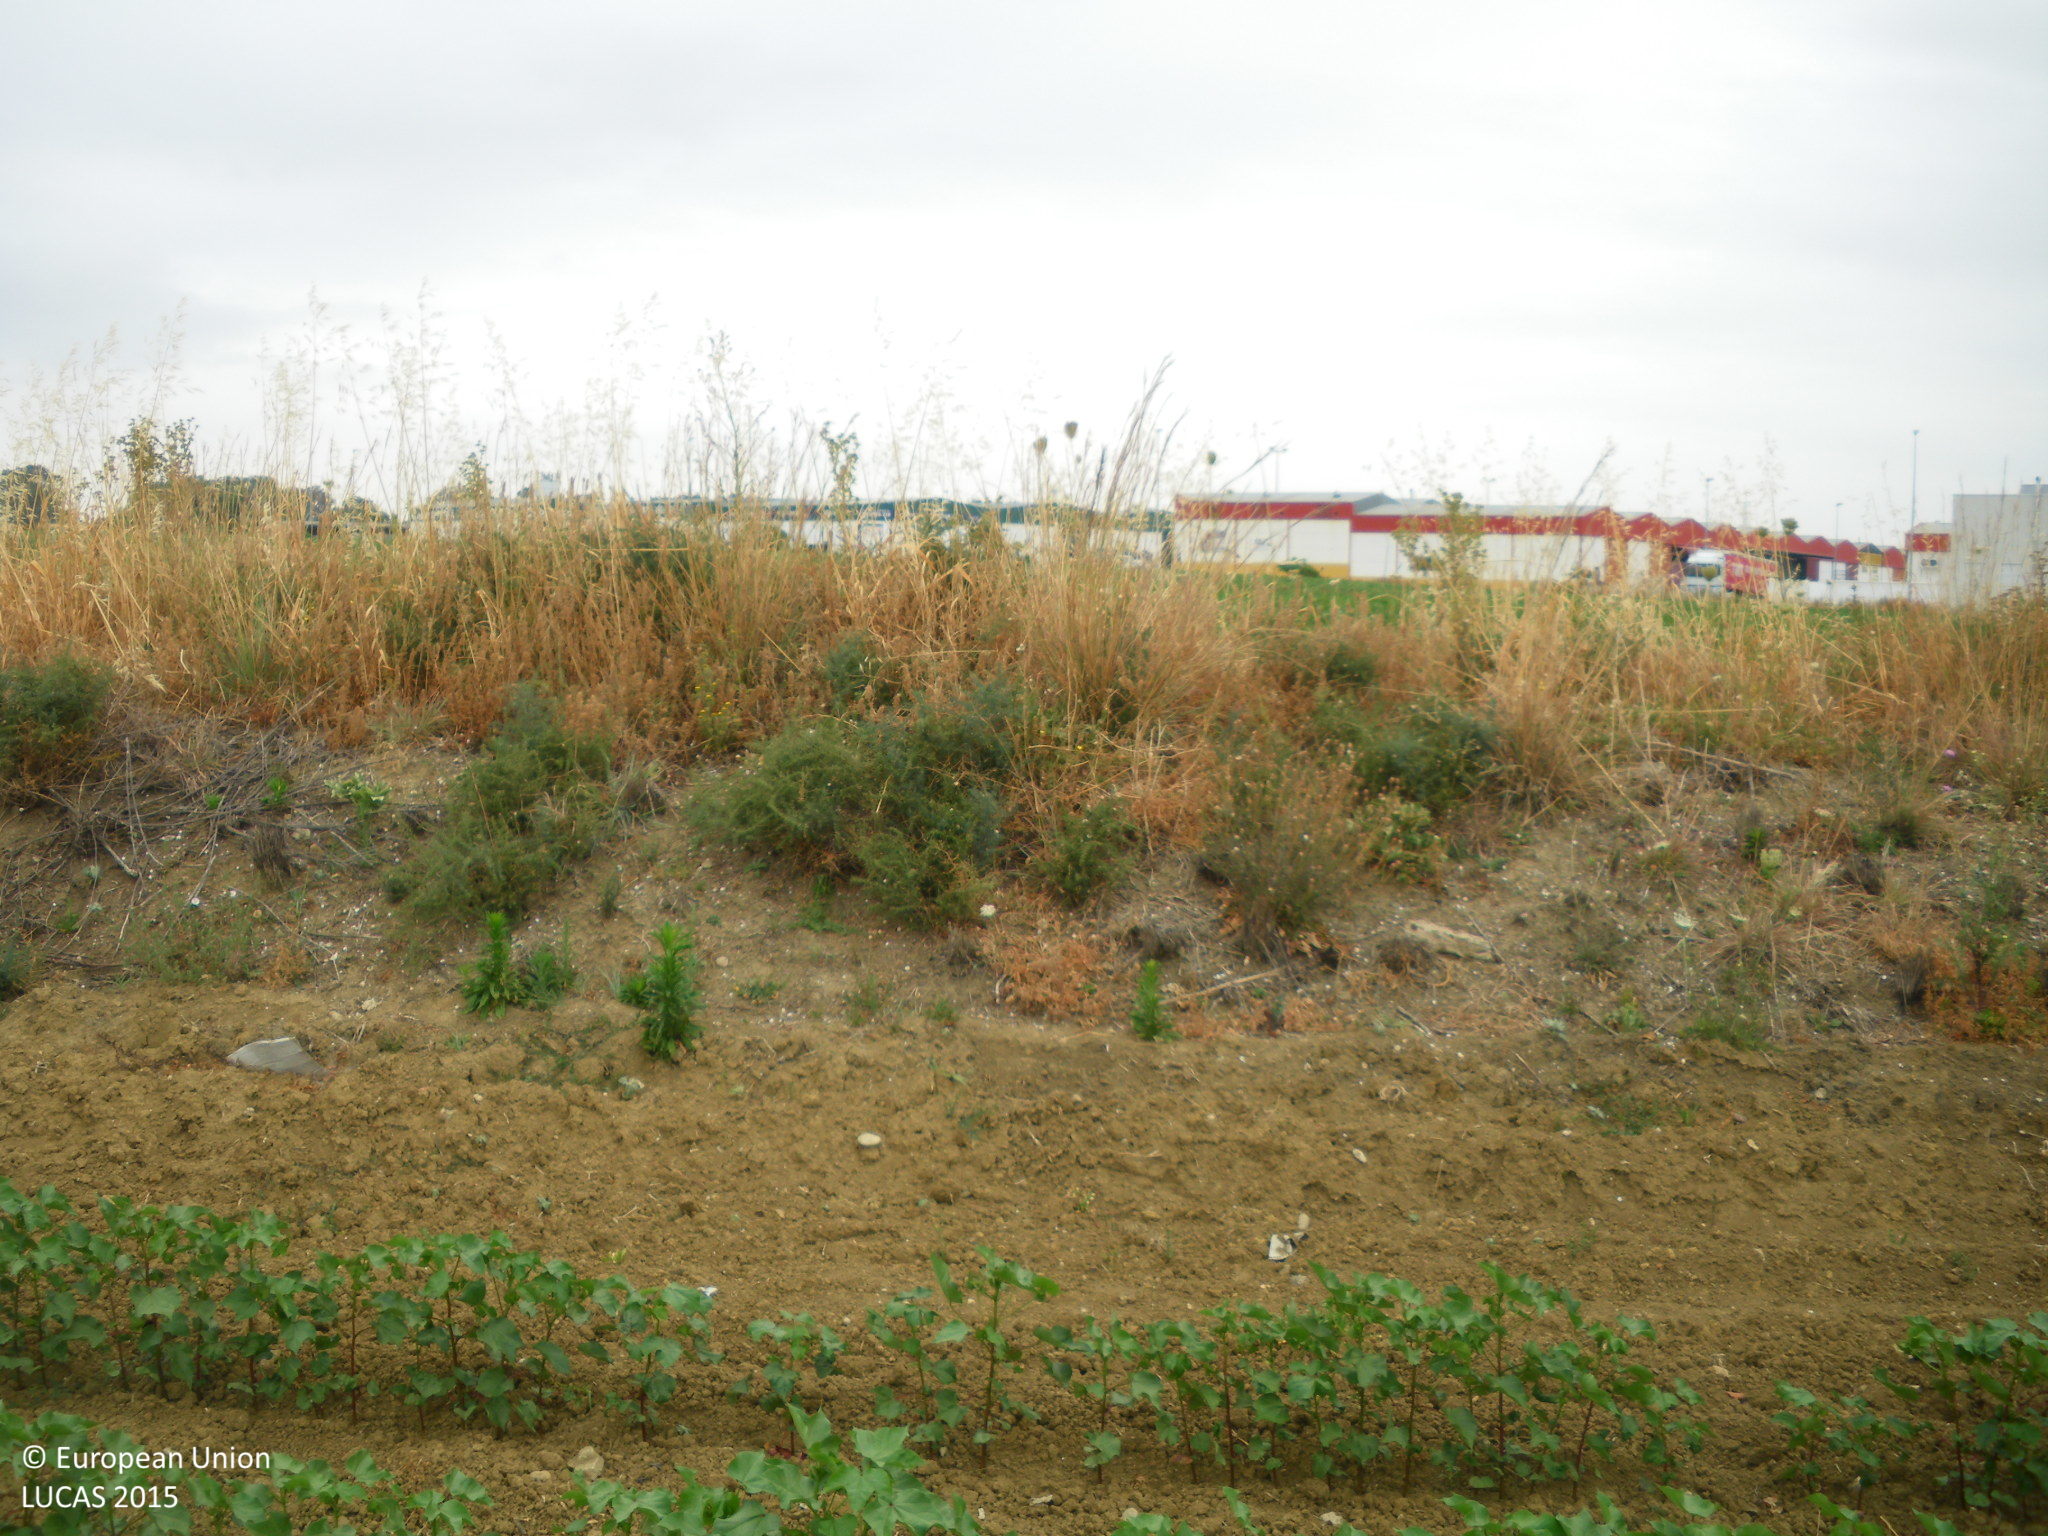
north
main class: Cropland
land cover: Cotton
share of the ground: 25 - 50 %
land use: Agriculture (excluding fallow land and kitchen gardens)
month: June
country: ES
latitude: 36.6503
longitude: -5.9487
